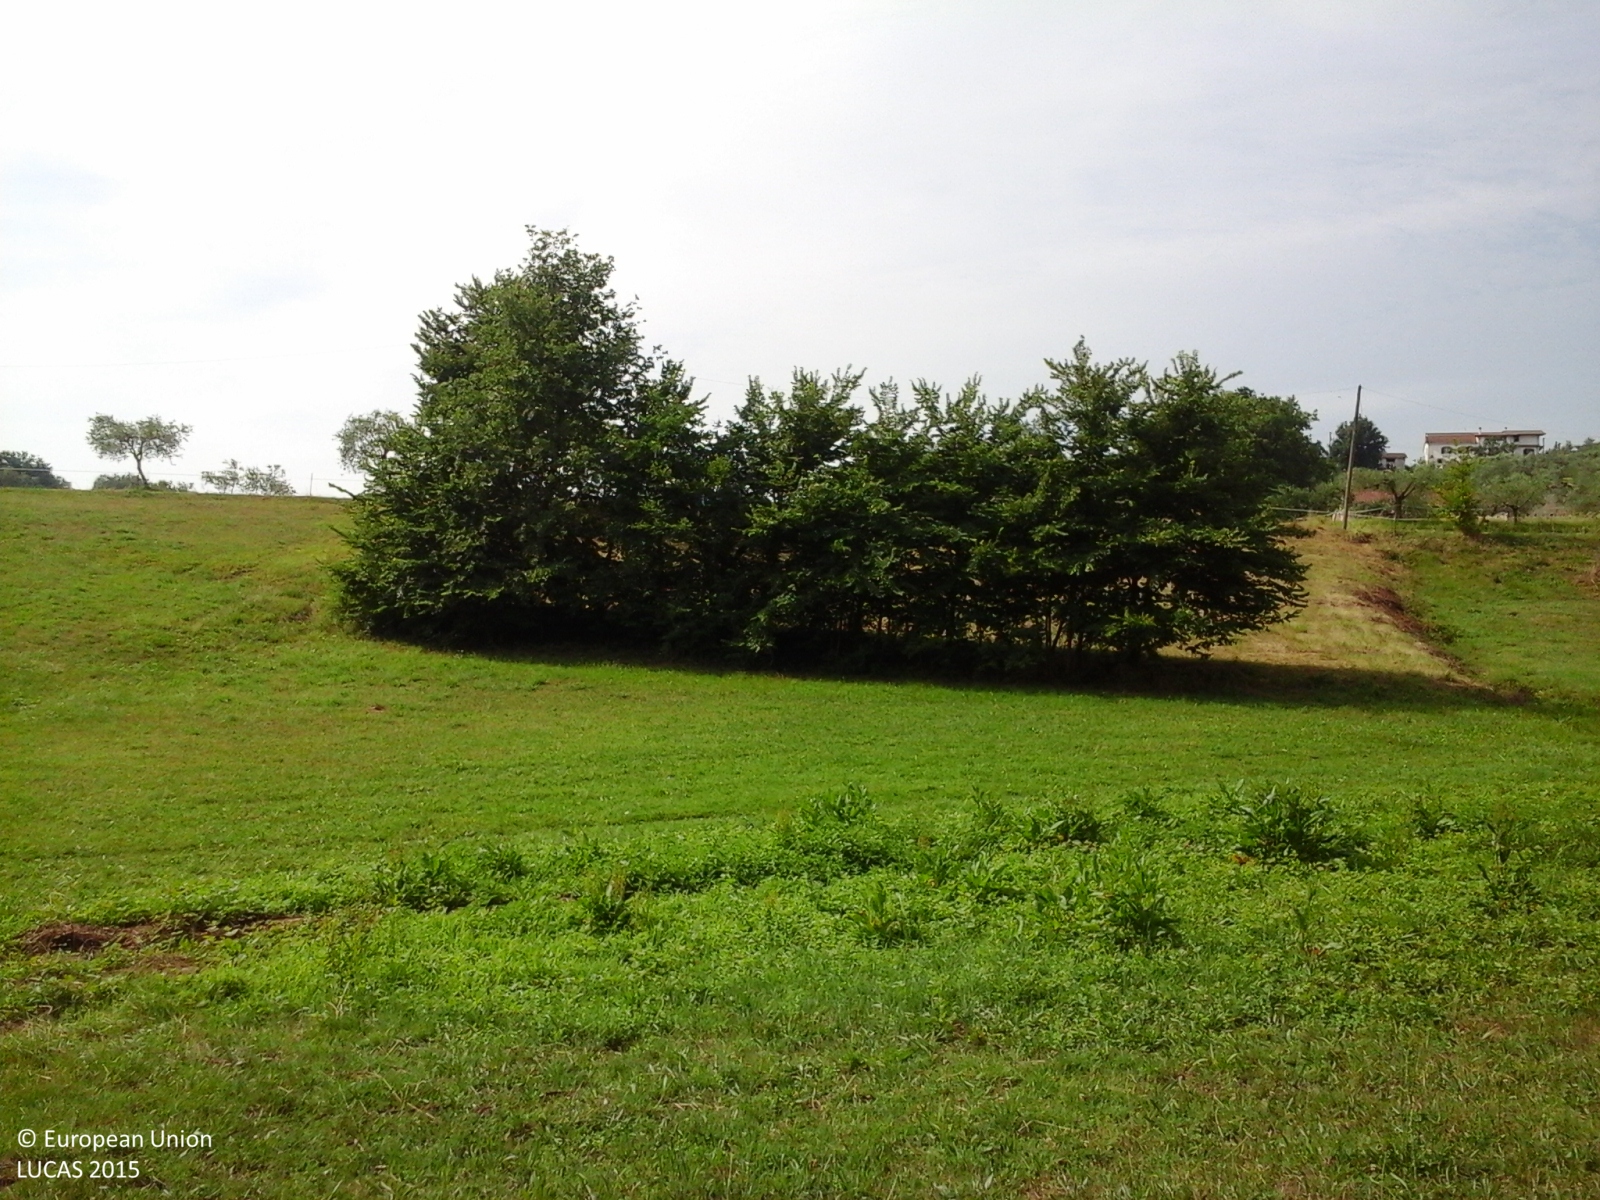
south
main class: Grassland
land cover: Grassland without tree/shrub cover
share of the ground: > 75 %
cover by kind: herbaceous plants 100 %
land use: Agriculture (excluding fallow land and kitchen gardens)
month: June
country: IT
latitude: 41.5841
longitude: 13.4056
